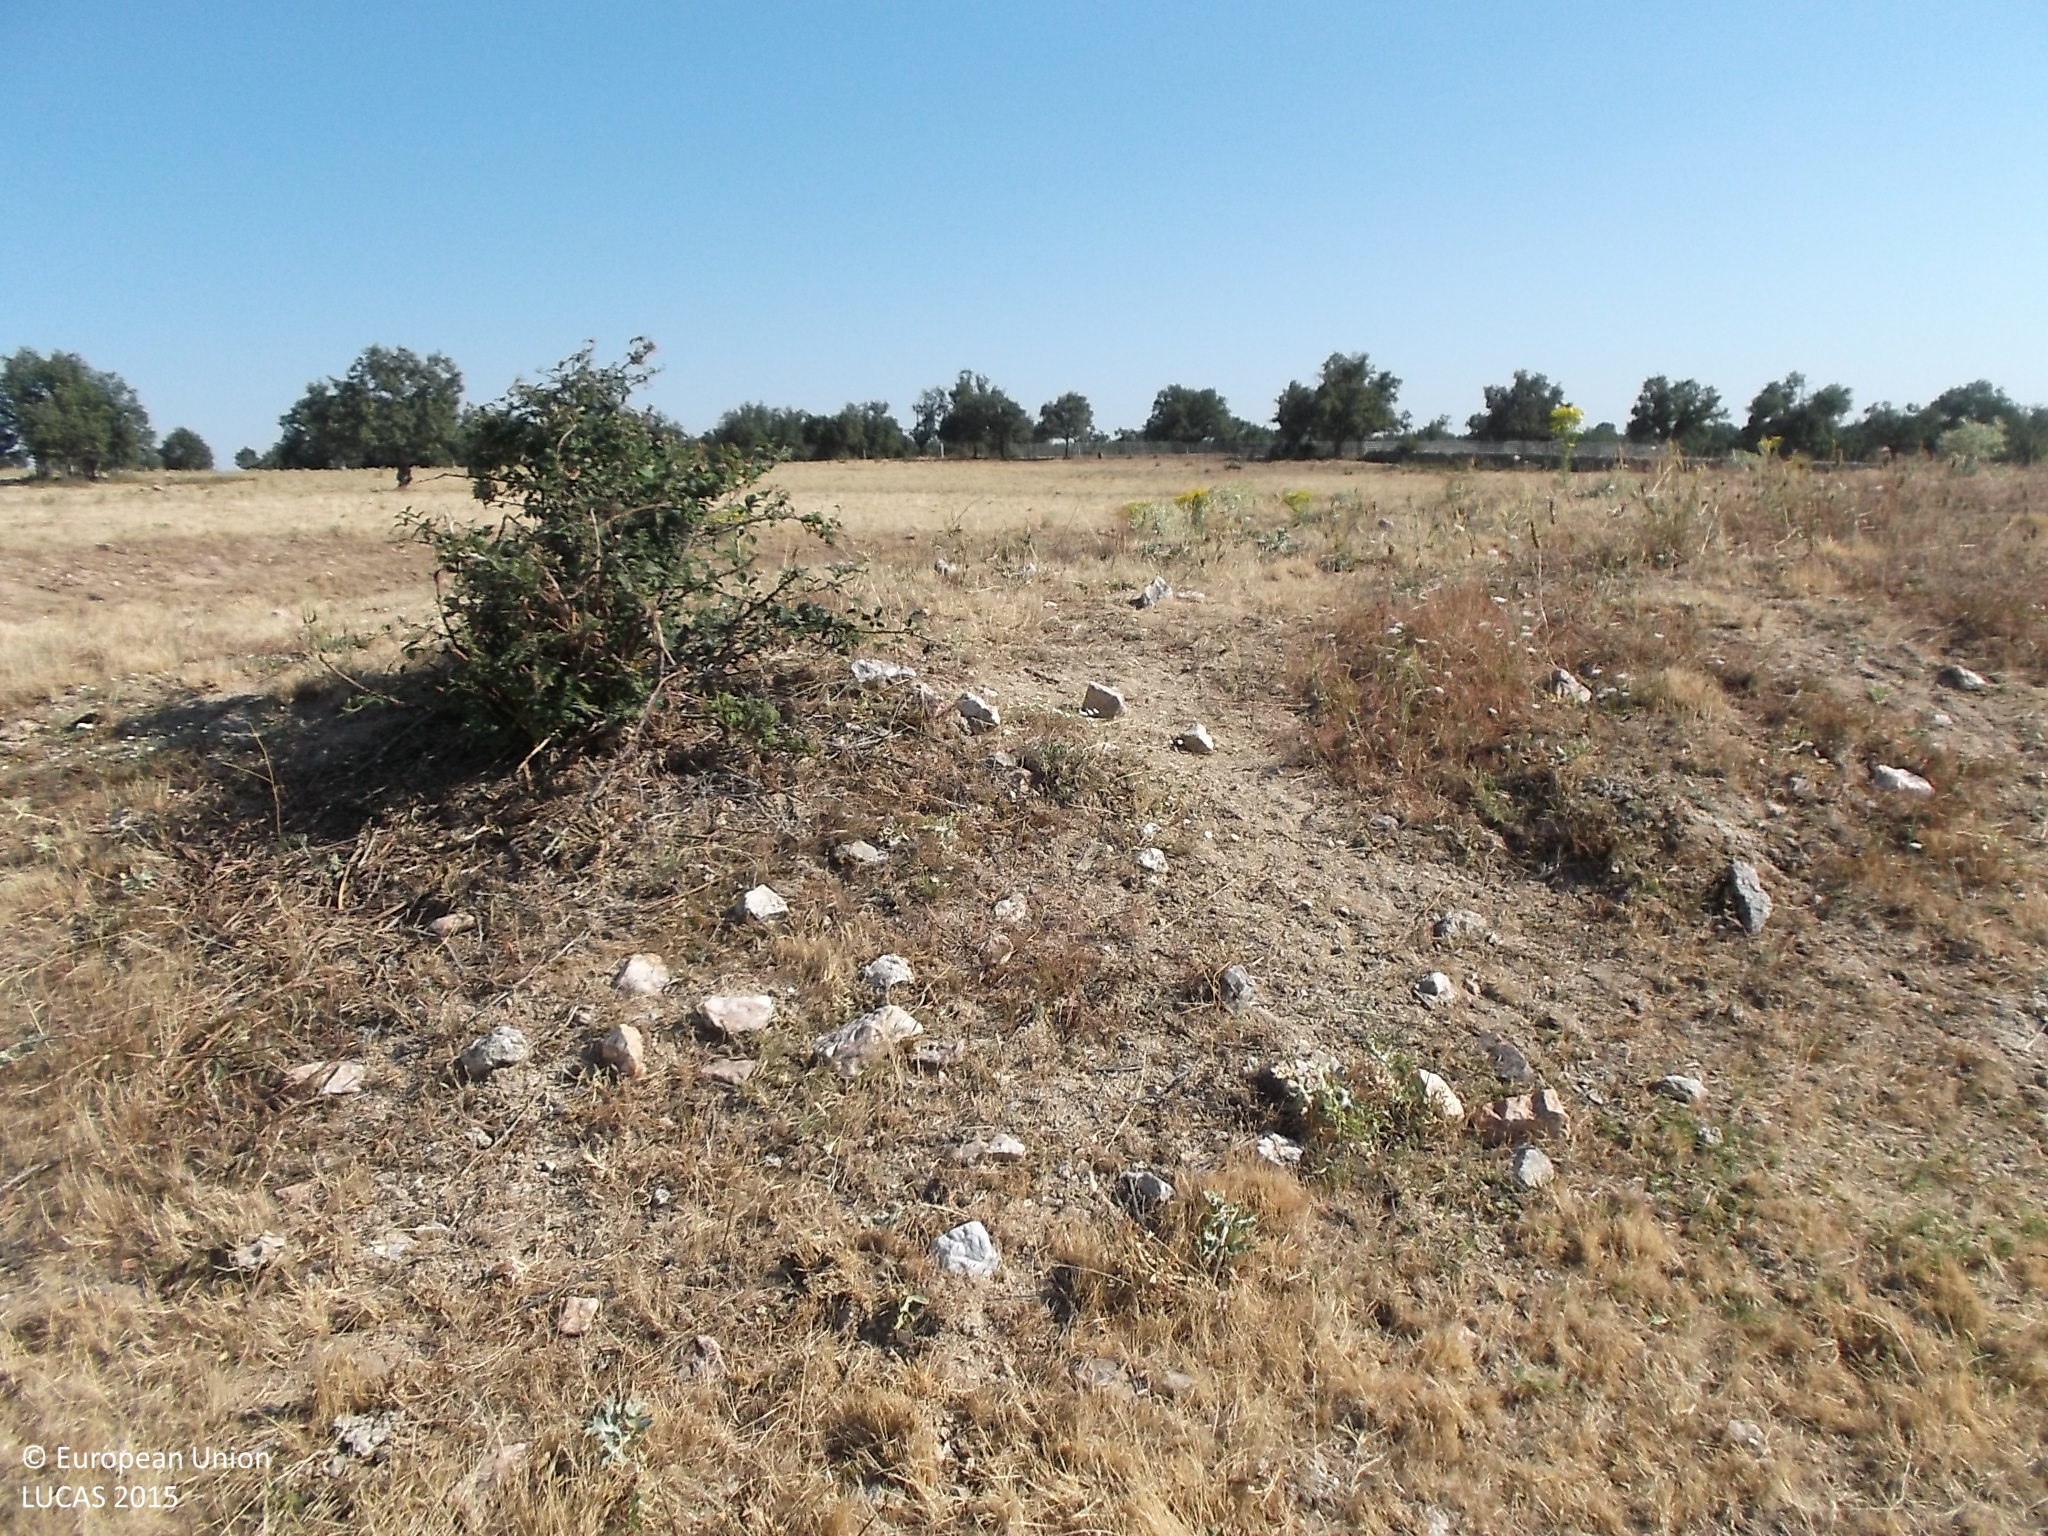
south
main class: Grassland
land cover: Grassland without tree/shrub cover
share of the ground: > 75 %
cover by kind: herbaceous plants 100 %
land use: Agriculture (excluding fallow land and kitchen gardens)
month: July
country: ES
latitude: 41.3014
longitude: -5.9848
